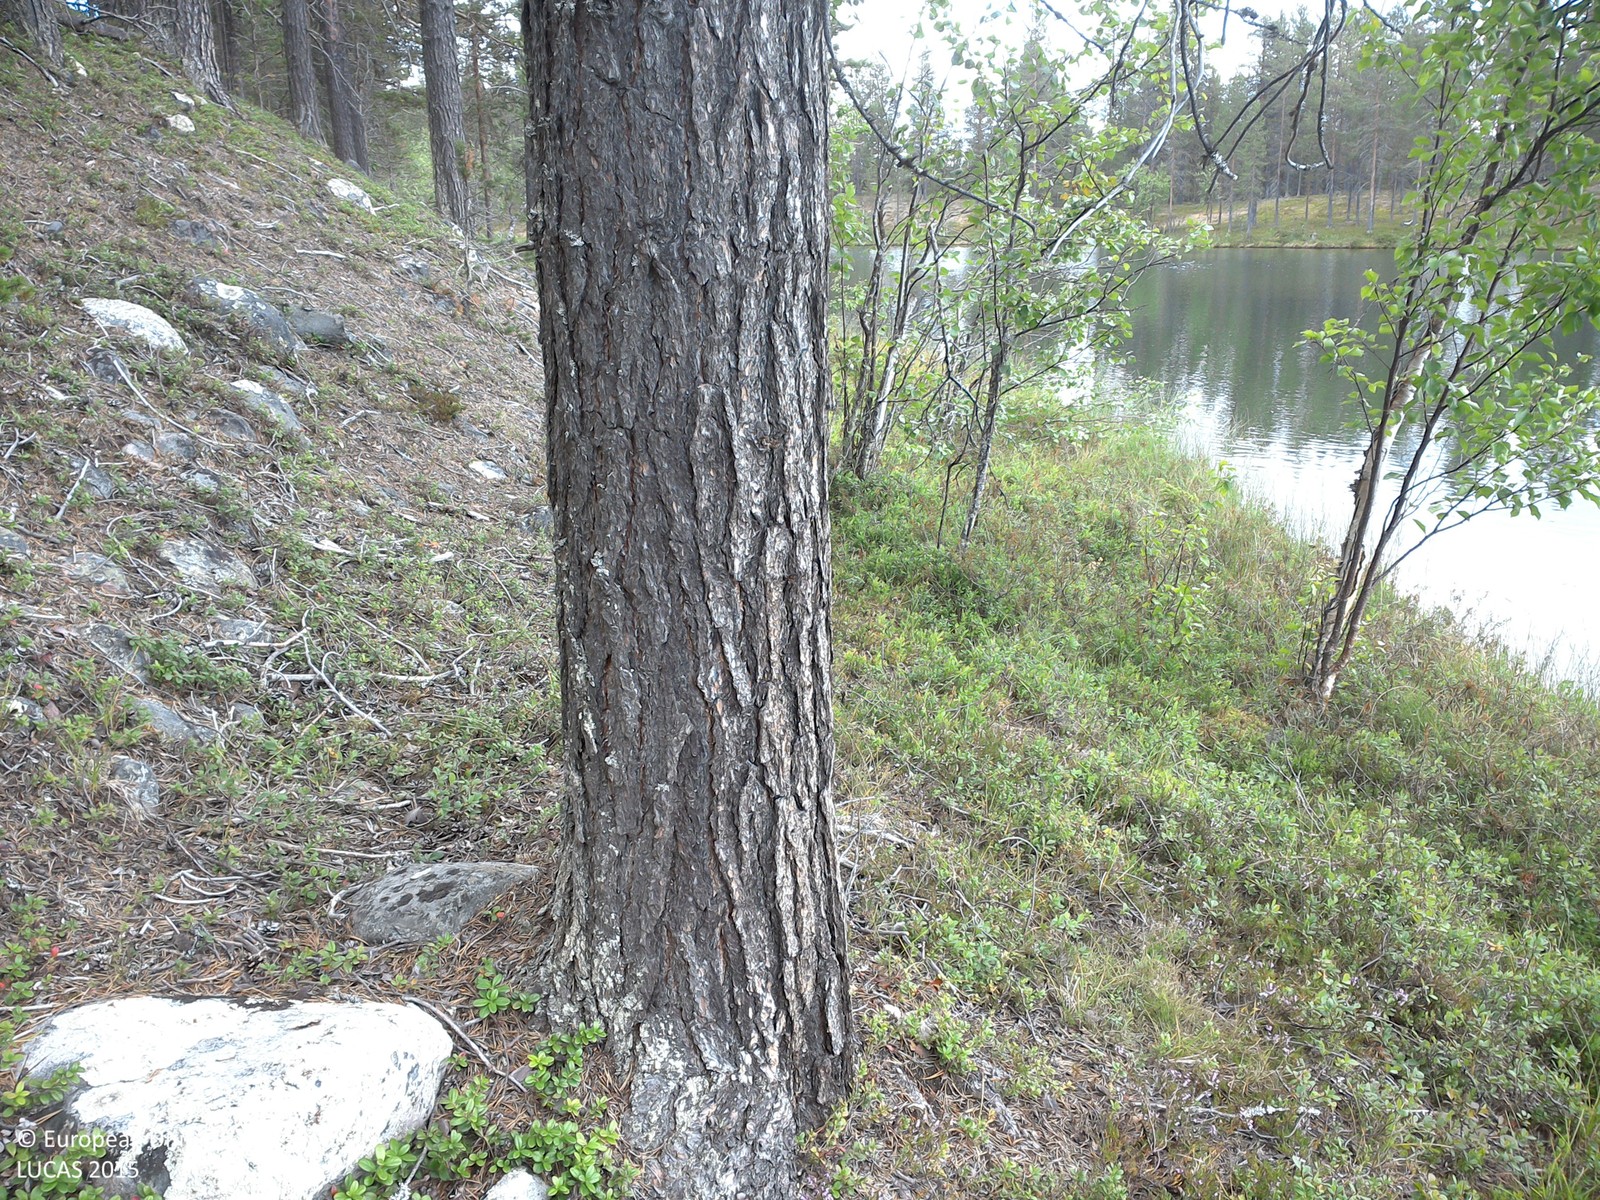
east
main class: Woodland
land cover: Pine dominated coniferous woodland
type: boreal forest
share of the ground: 25 - 50 %
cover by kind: shrubs 60 %, coniferous forest trees 25 %, unconsolidated bare surface 10 %, lichens and mosses 5 %
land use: Forestry
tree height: > 5 m
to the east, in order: Pine dominated coniferous woodland; Inland fresh water bodies; Pine dominated coniferous woodland; Pine dominated mixed woodland; Inland marshes
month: August
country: SE
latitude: 67.4910
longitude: 21.5838
